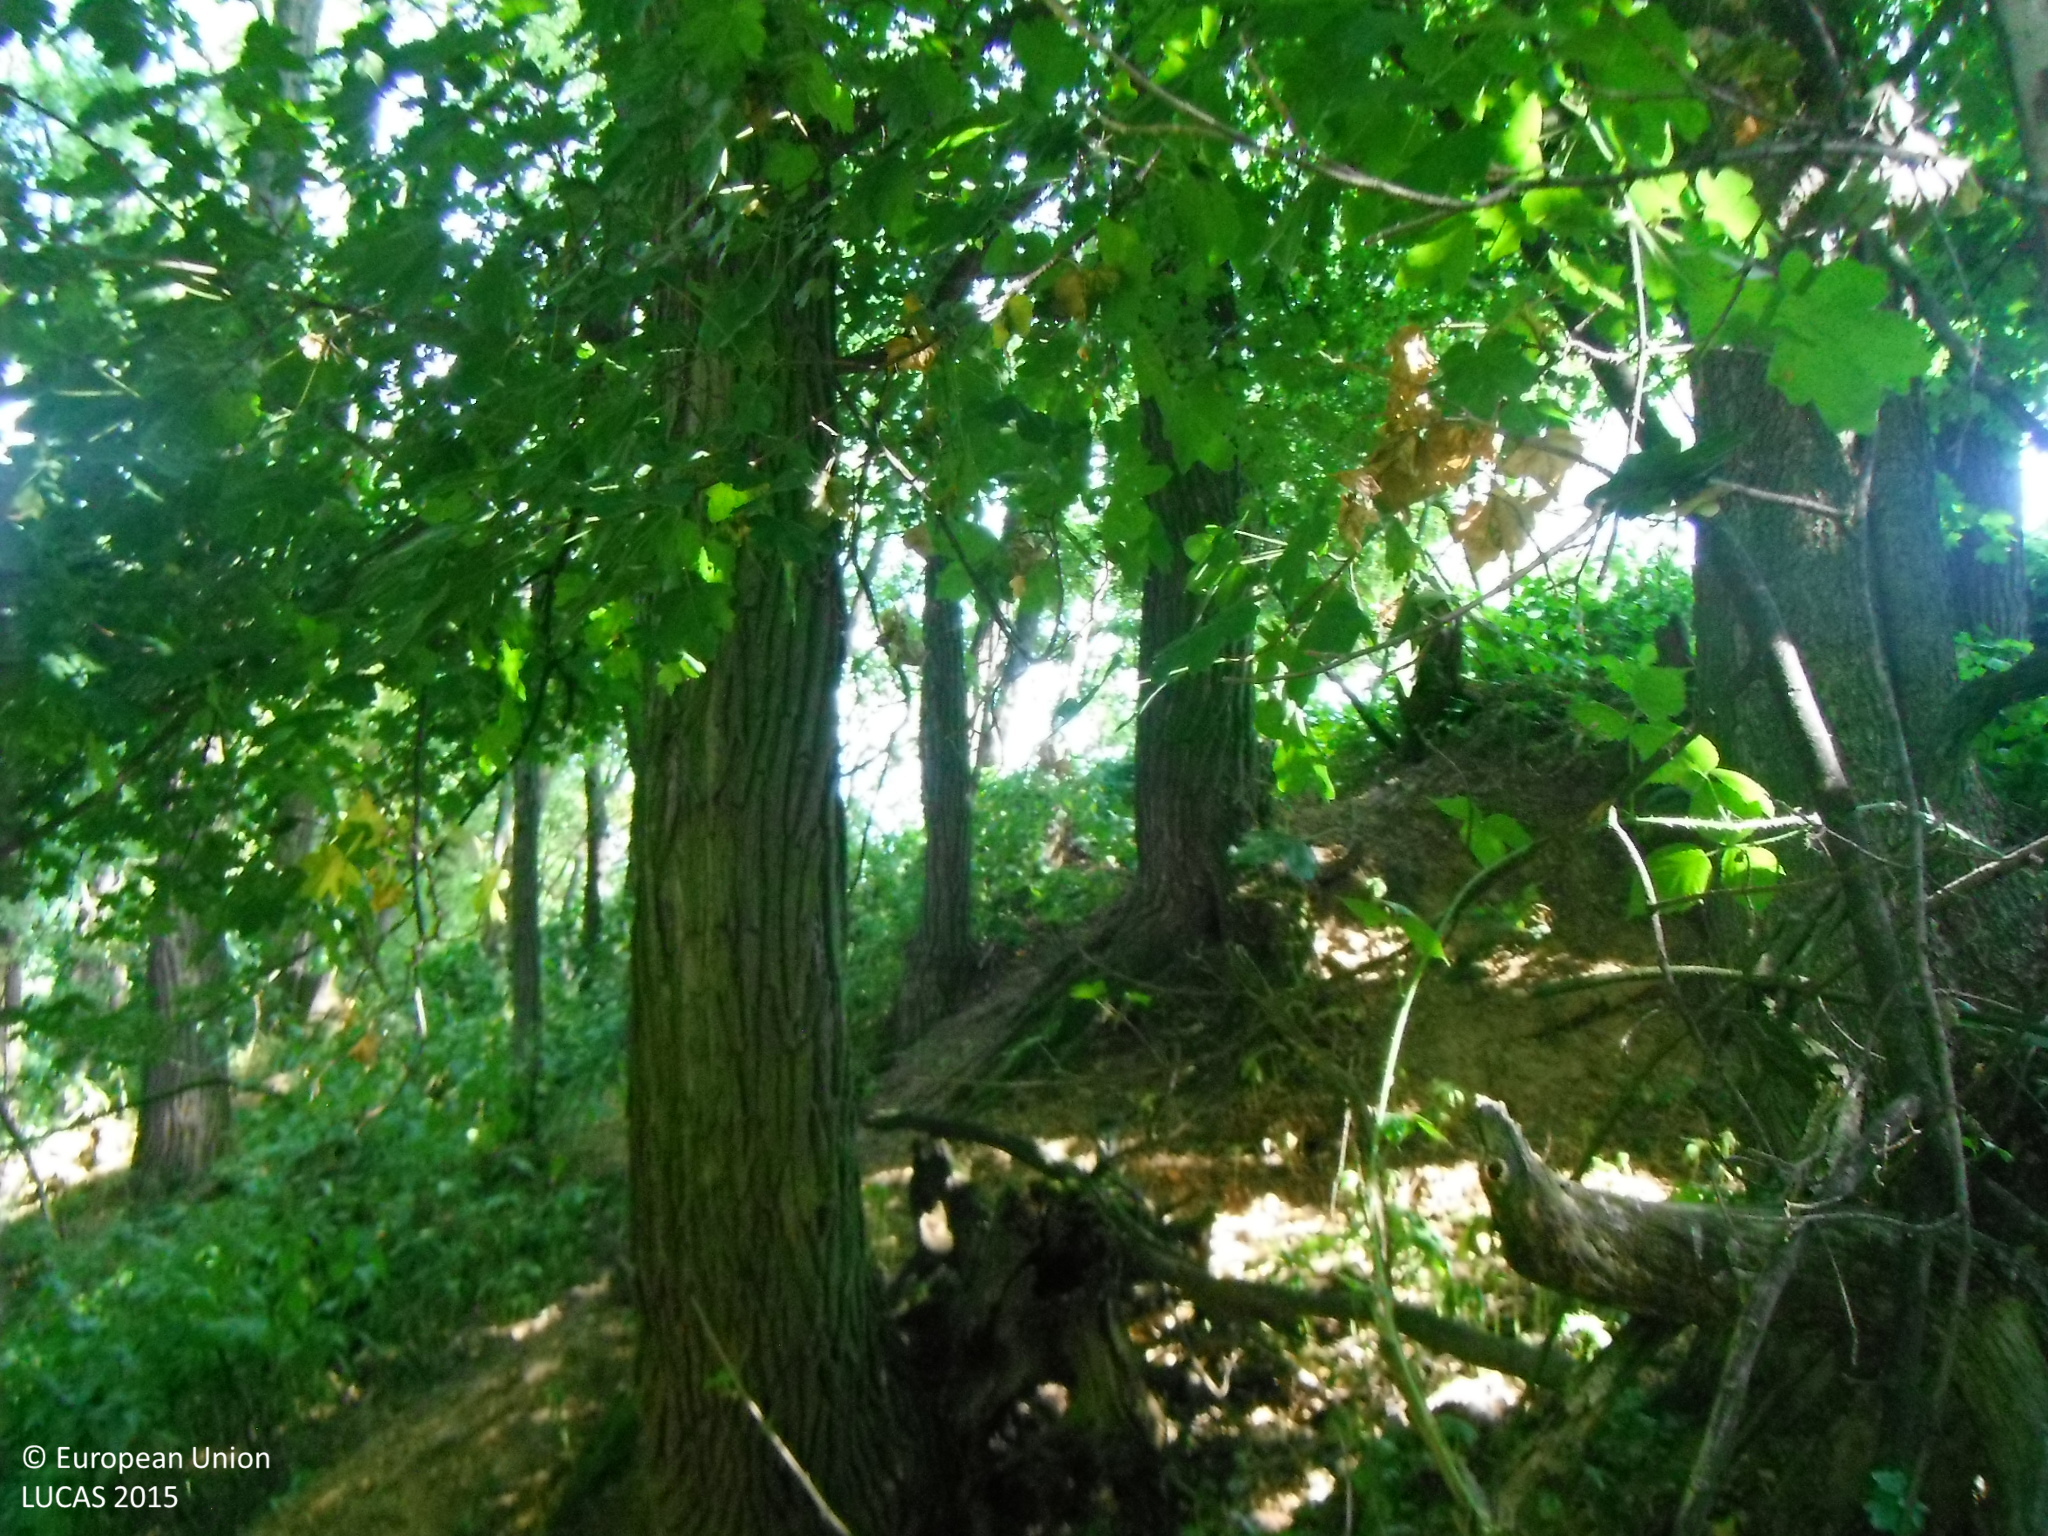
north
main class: Woodland
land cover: Broadleaved woodland
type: mesophytic deciduous forest
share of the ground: > 75 %
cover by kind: broadleaved forest trees 90 %, shrubs 5 %, herbaceous plants 5 %
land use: Semi-natural and natural areas not in use
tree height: > 5 m
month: July
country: SK
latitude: 48.6391
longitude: 17.4611
